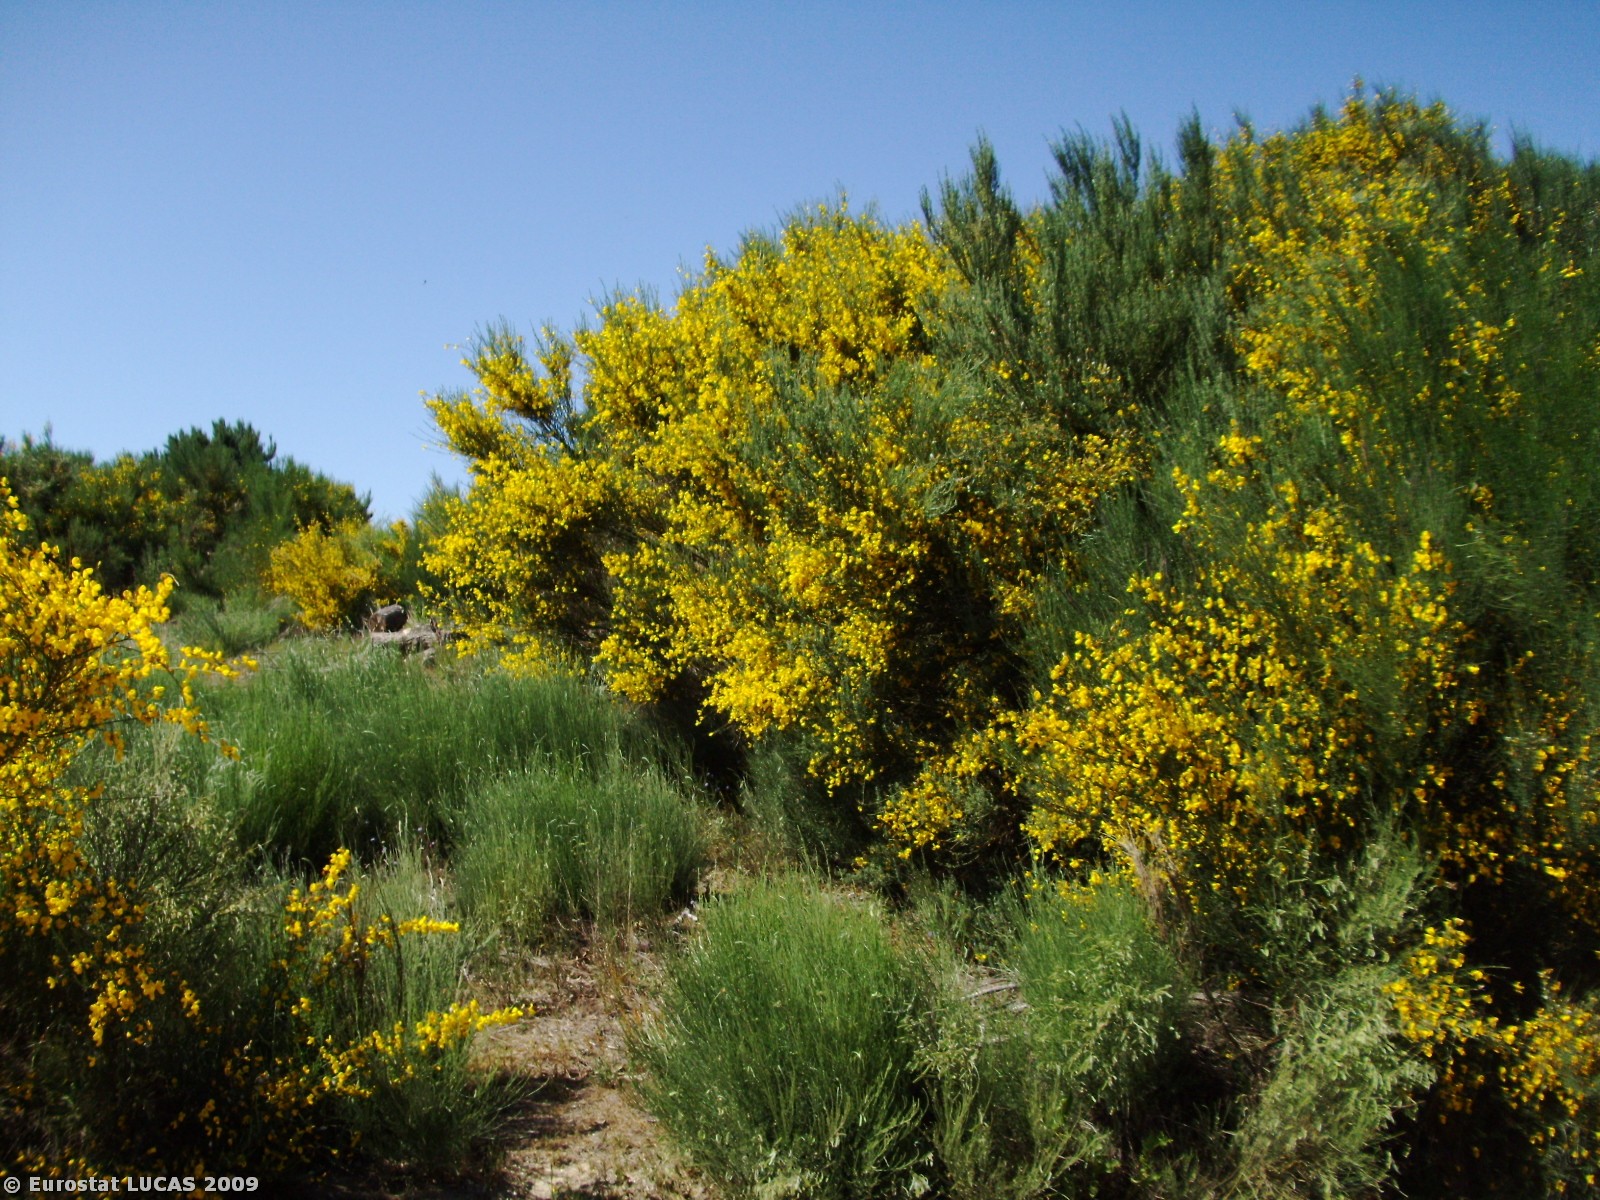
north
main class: Cropland
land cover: Nuts trees
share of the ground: 25 - 50 %
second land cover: Bare land
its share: 25 - 50 %
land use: Agriculture (excluding fallow land and kitchen gardens)
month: May
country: PT
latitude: 40.9032
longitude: -7.5579
